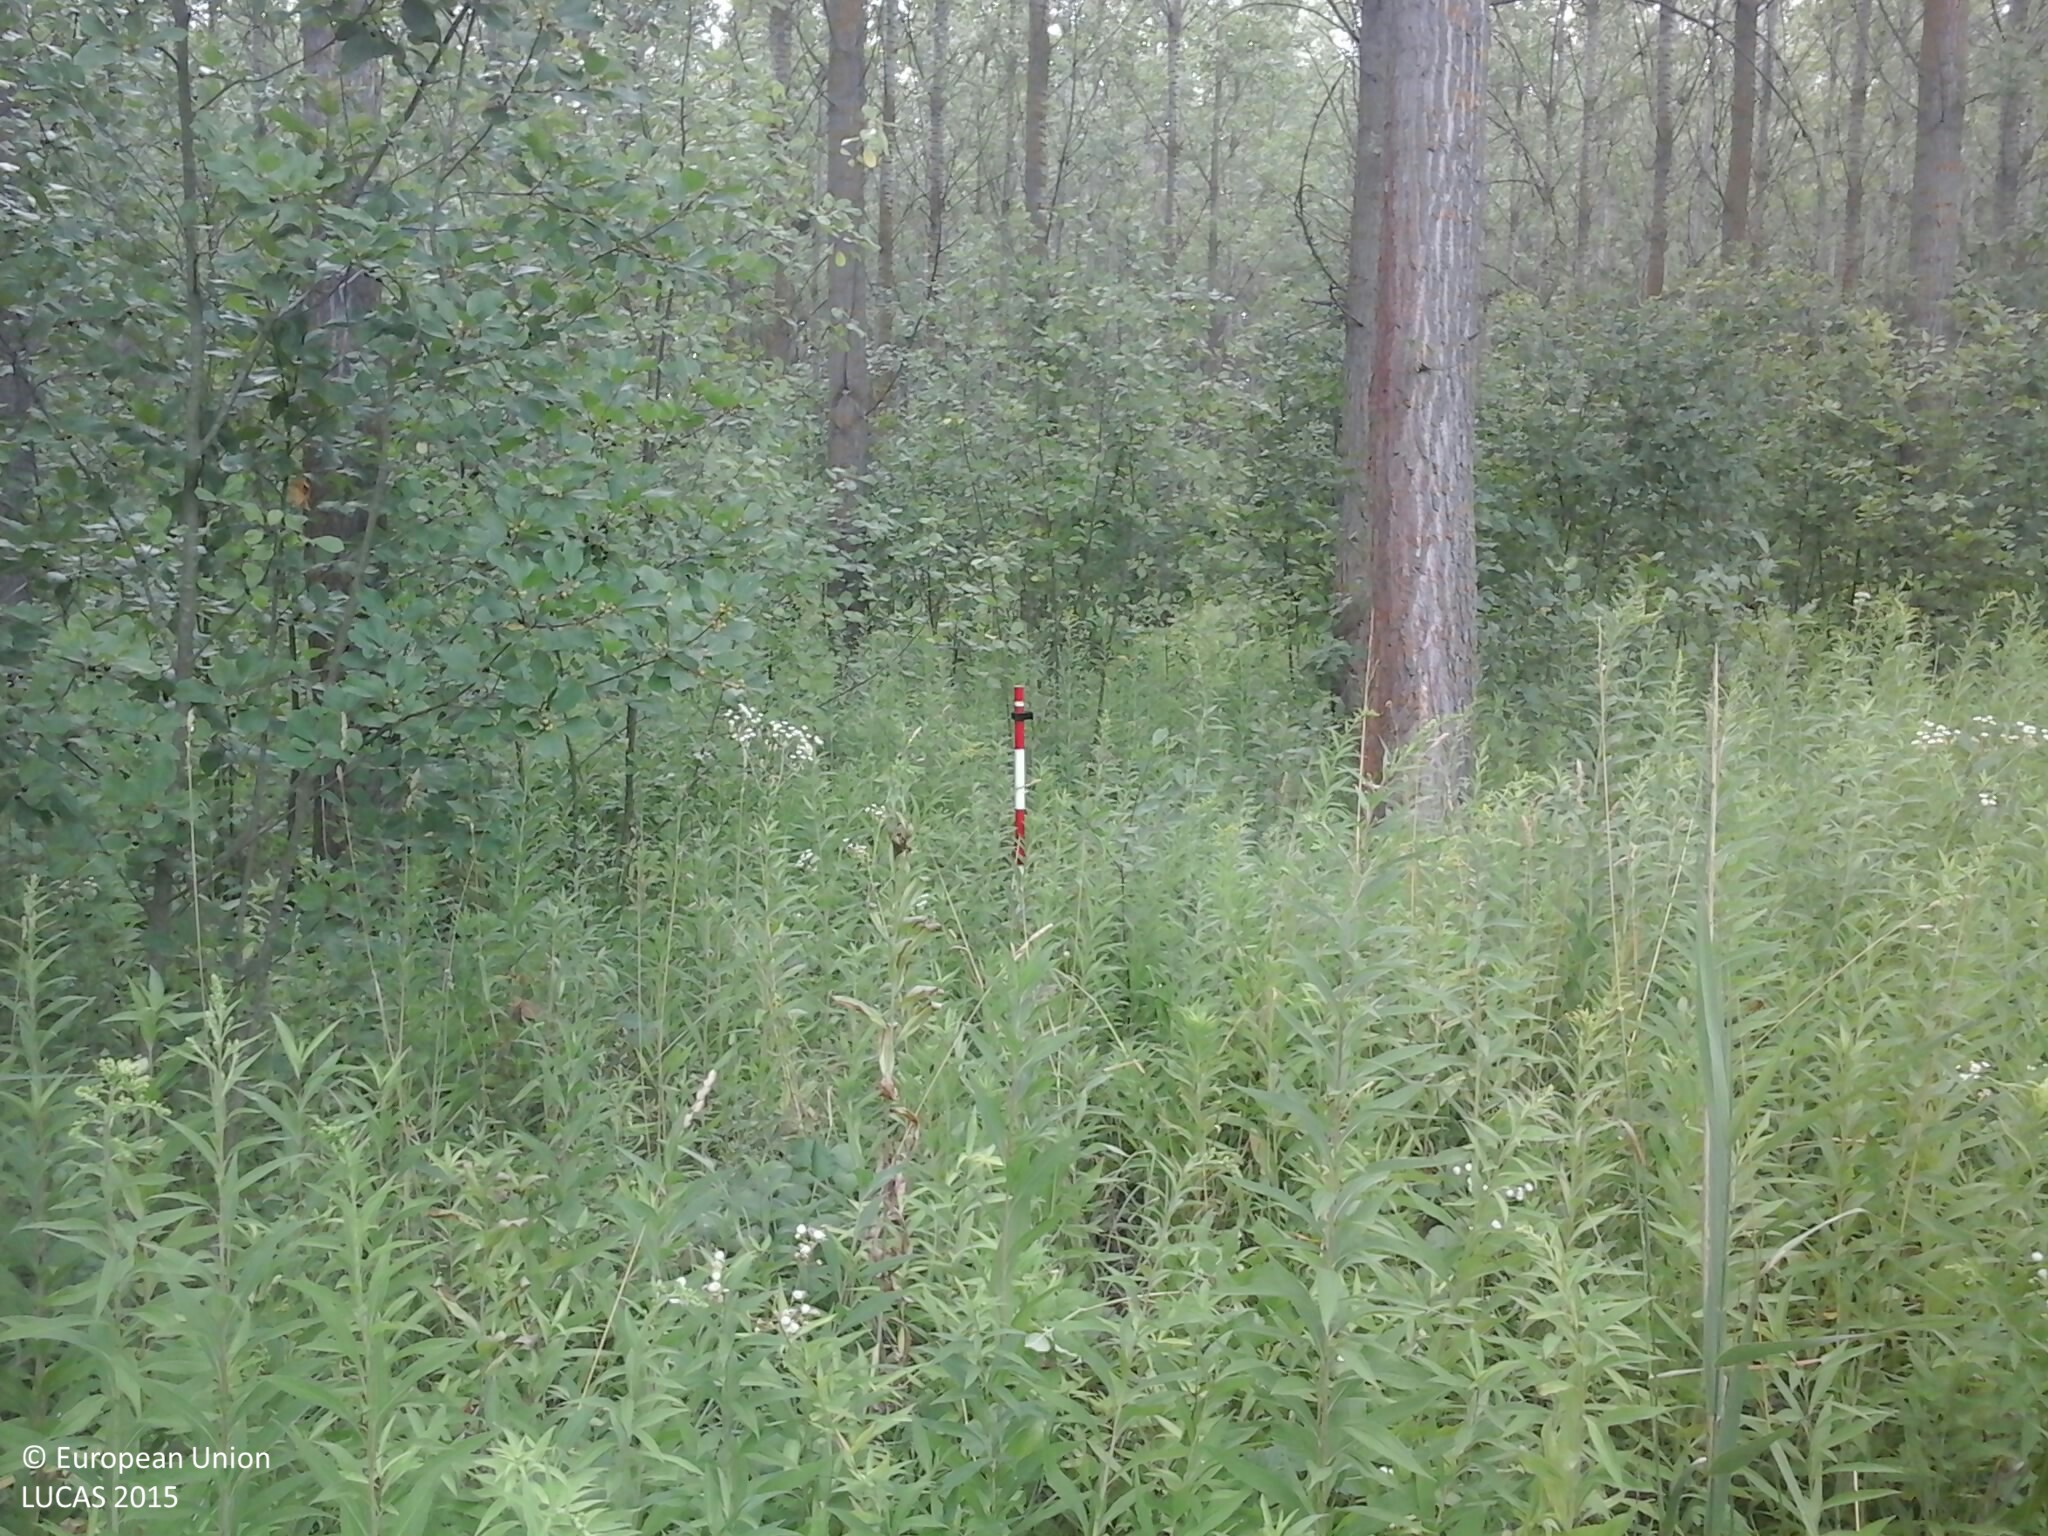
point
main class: Woodland
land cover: Broadleaved woodland
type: non-riverine alder, birch or aspen forest
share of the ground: > 75 %
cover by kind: broadleaved forest trees 80 %, shrubs 10 %, herbaceous plants 10 %
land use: Forestry
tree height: > 5 m
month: July
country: HU
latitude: 47.7428
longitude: 22.2034
